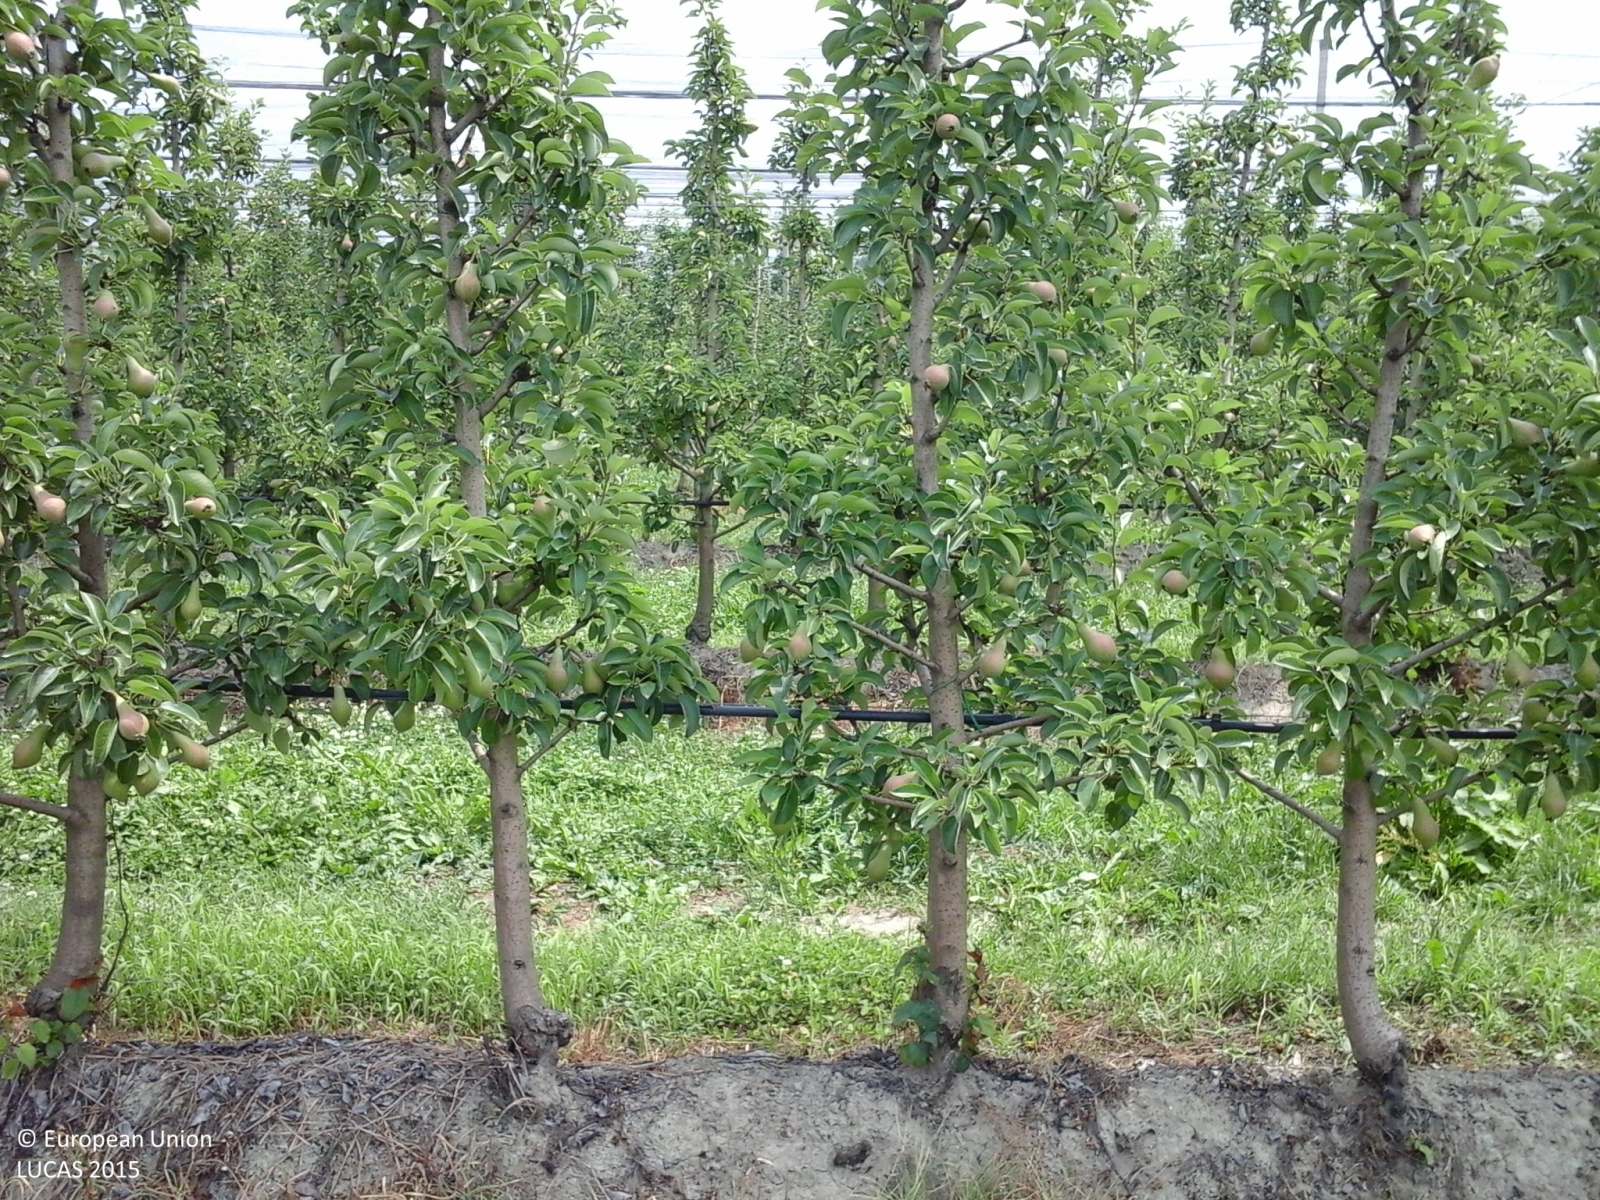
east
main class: Cropland
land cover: Pear fruit
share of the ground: 25 - 50 %
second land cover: Grassland without tree/shrub cover
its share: > 75 %
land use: Agriculture (excluding fallow land and kitchen gardens)
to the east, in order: Pear fruit; Grassland without tree/shrub cover
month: June
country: IT
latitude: 44.8764
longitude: 11.7814
